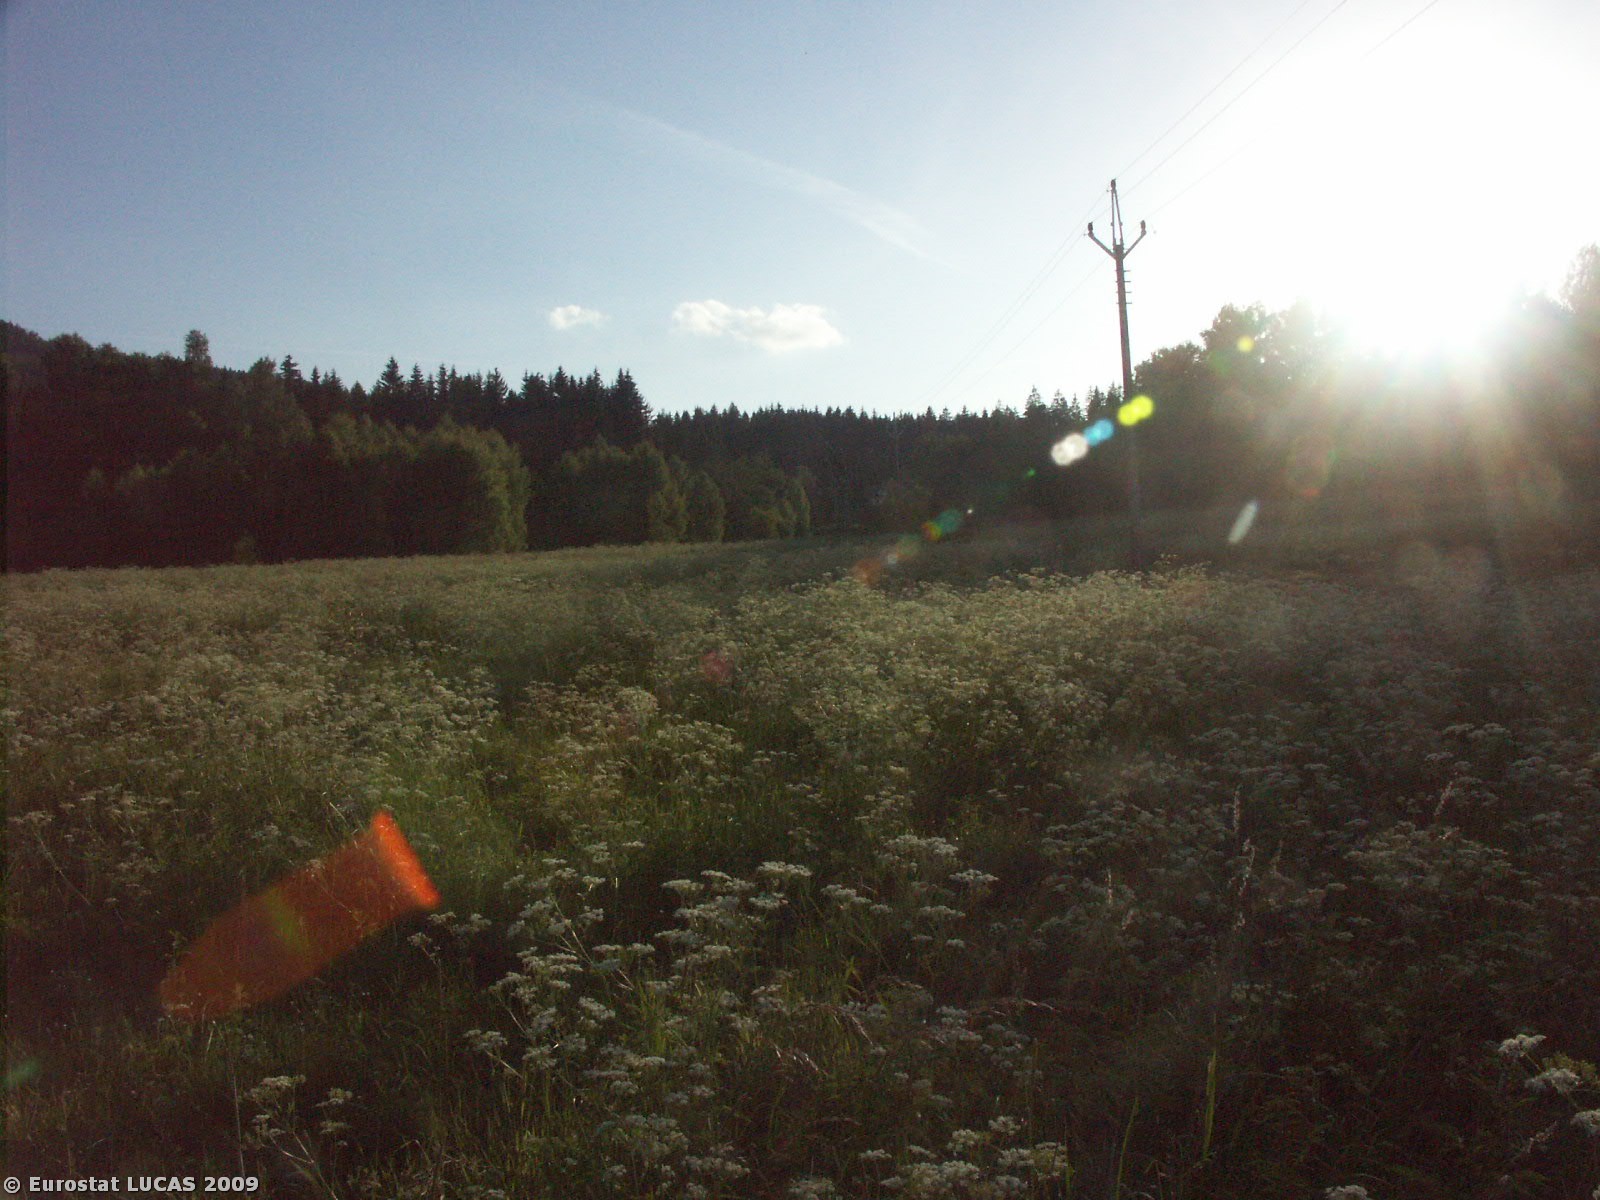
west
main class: Grassland
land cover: Grassland without tree/shrub cover
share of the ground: > 75 %
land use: Unused
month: June
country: CZ
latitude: 48.6452
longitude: 14.2758
